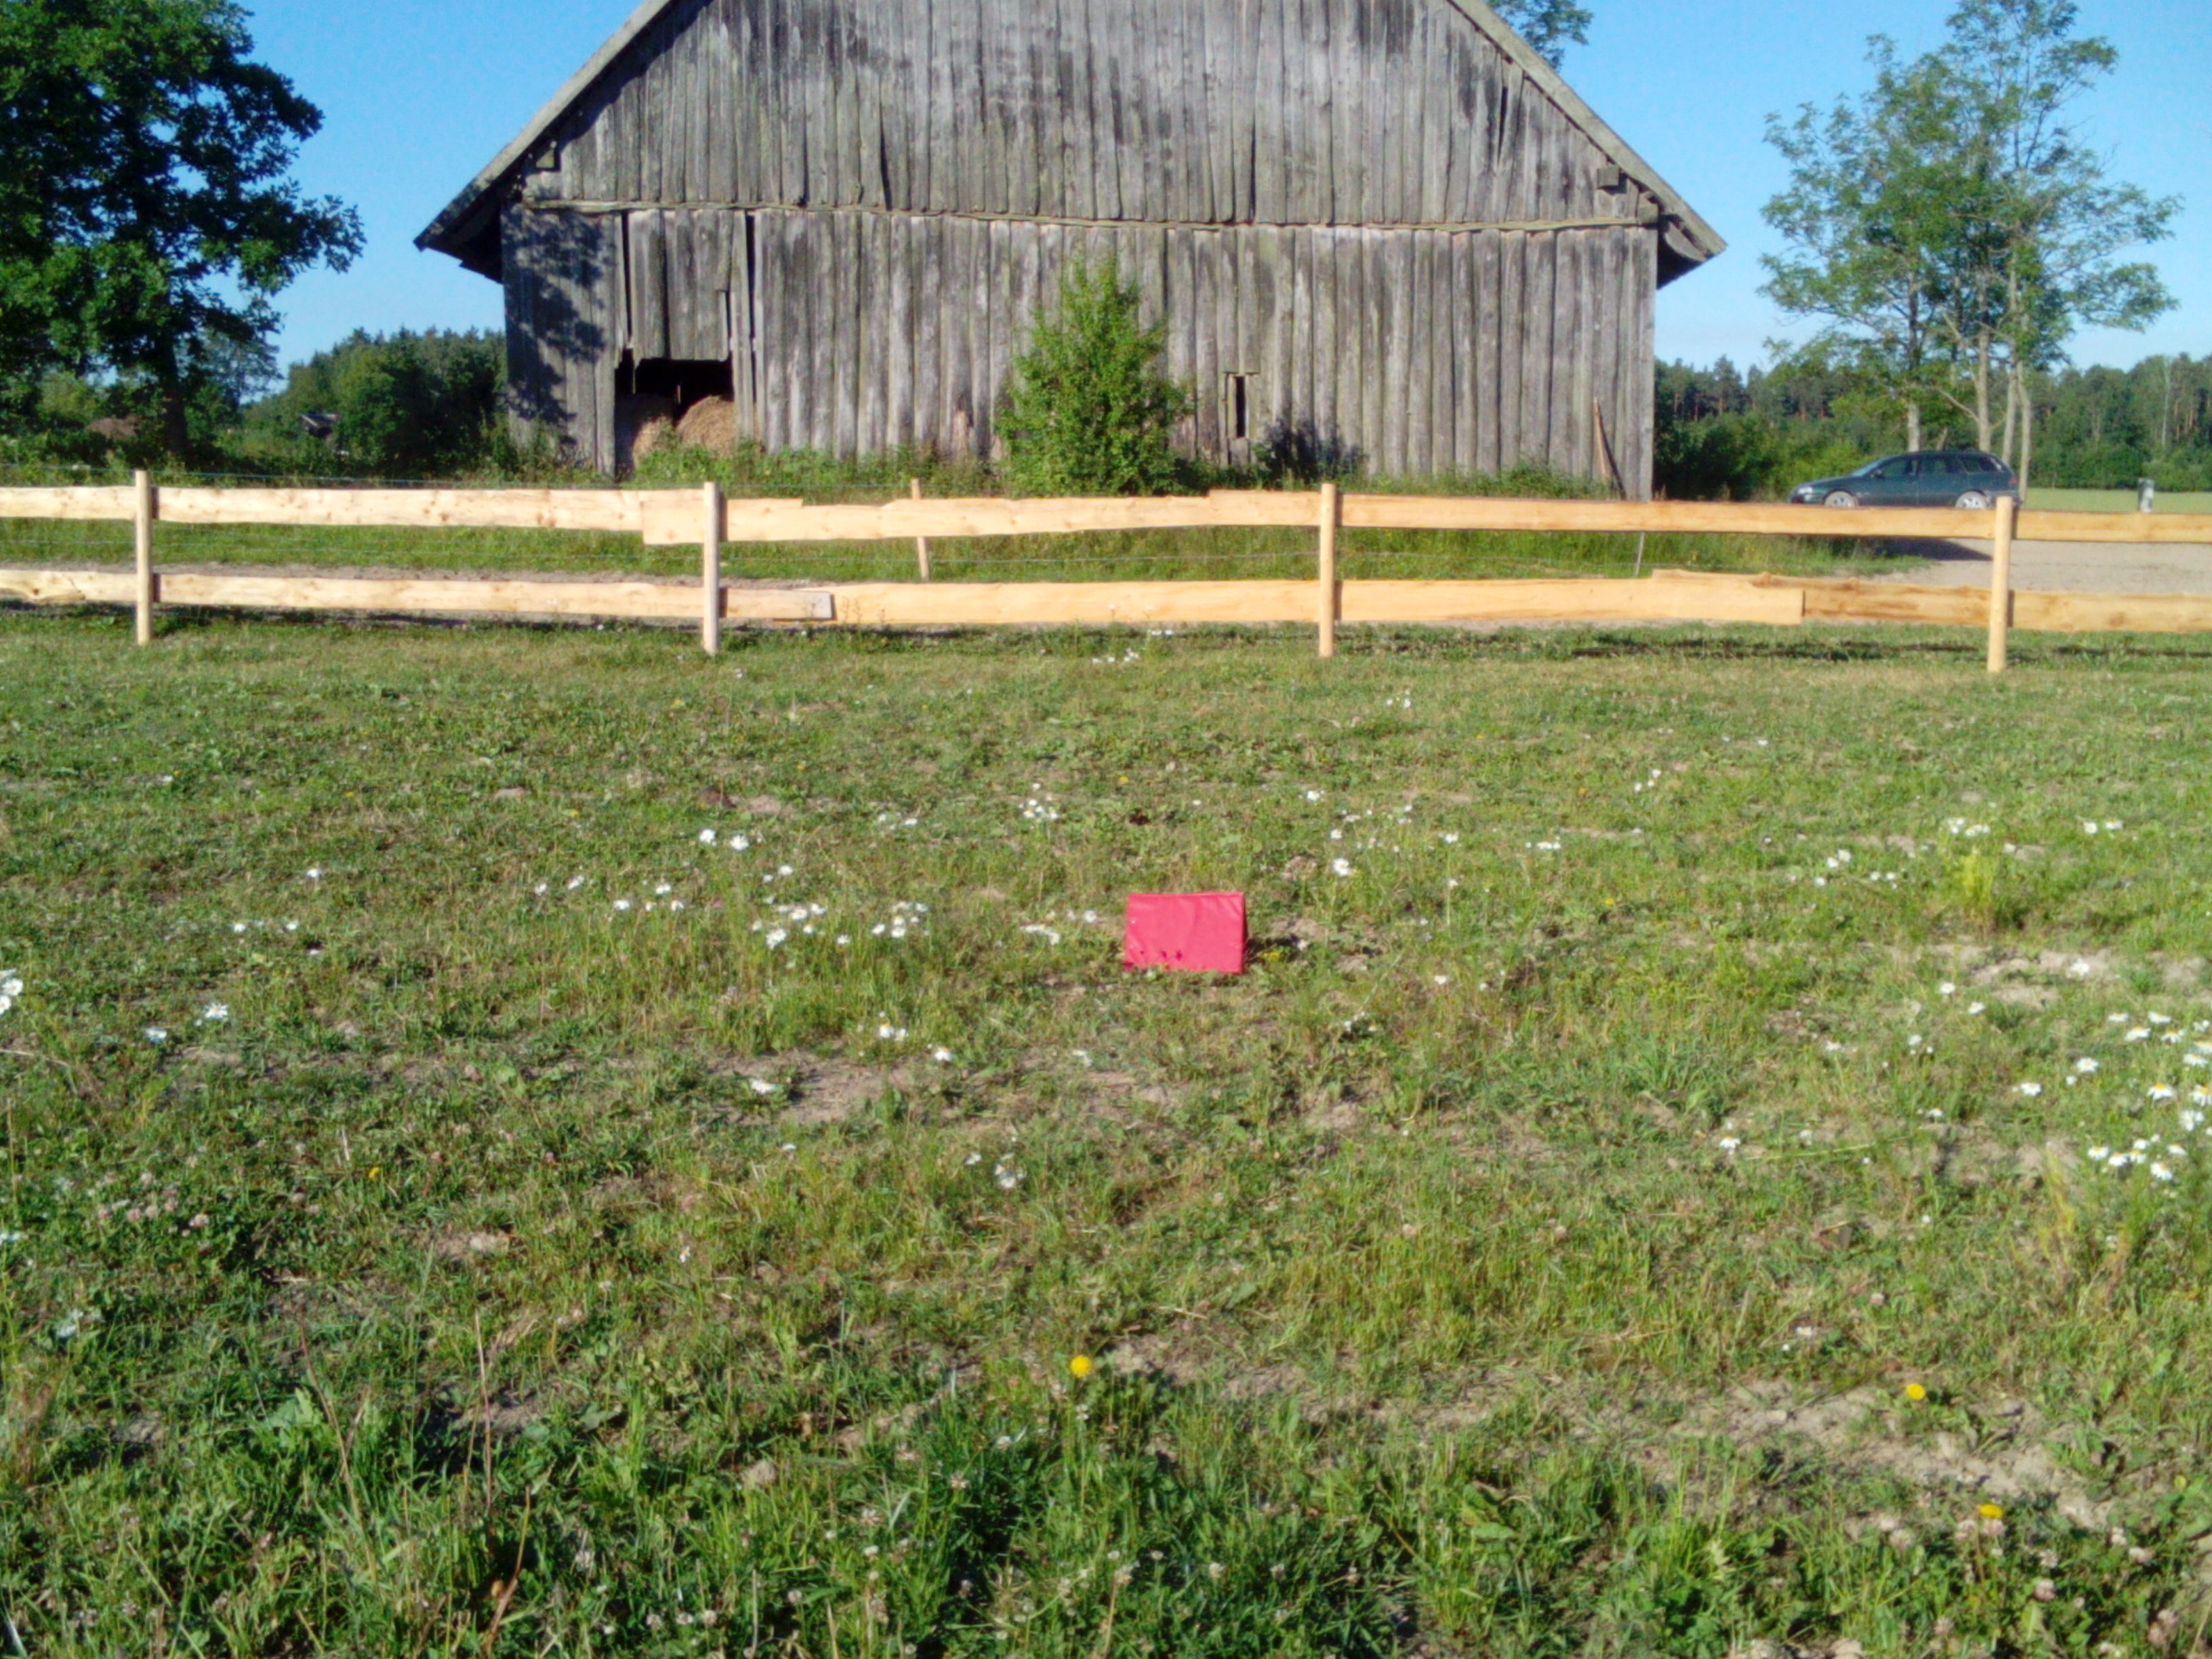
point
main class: Grassland
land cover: Grassland without tree/shrub cover
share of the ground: > 75 %
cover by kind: herbaceous plants 80 %, unconsolidated bare surface 20 %
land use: Agriculture (excluding fallow land and kitchen gardens)
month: July
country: LV
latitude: 56.4258
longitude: 22.1638
